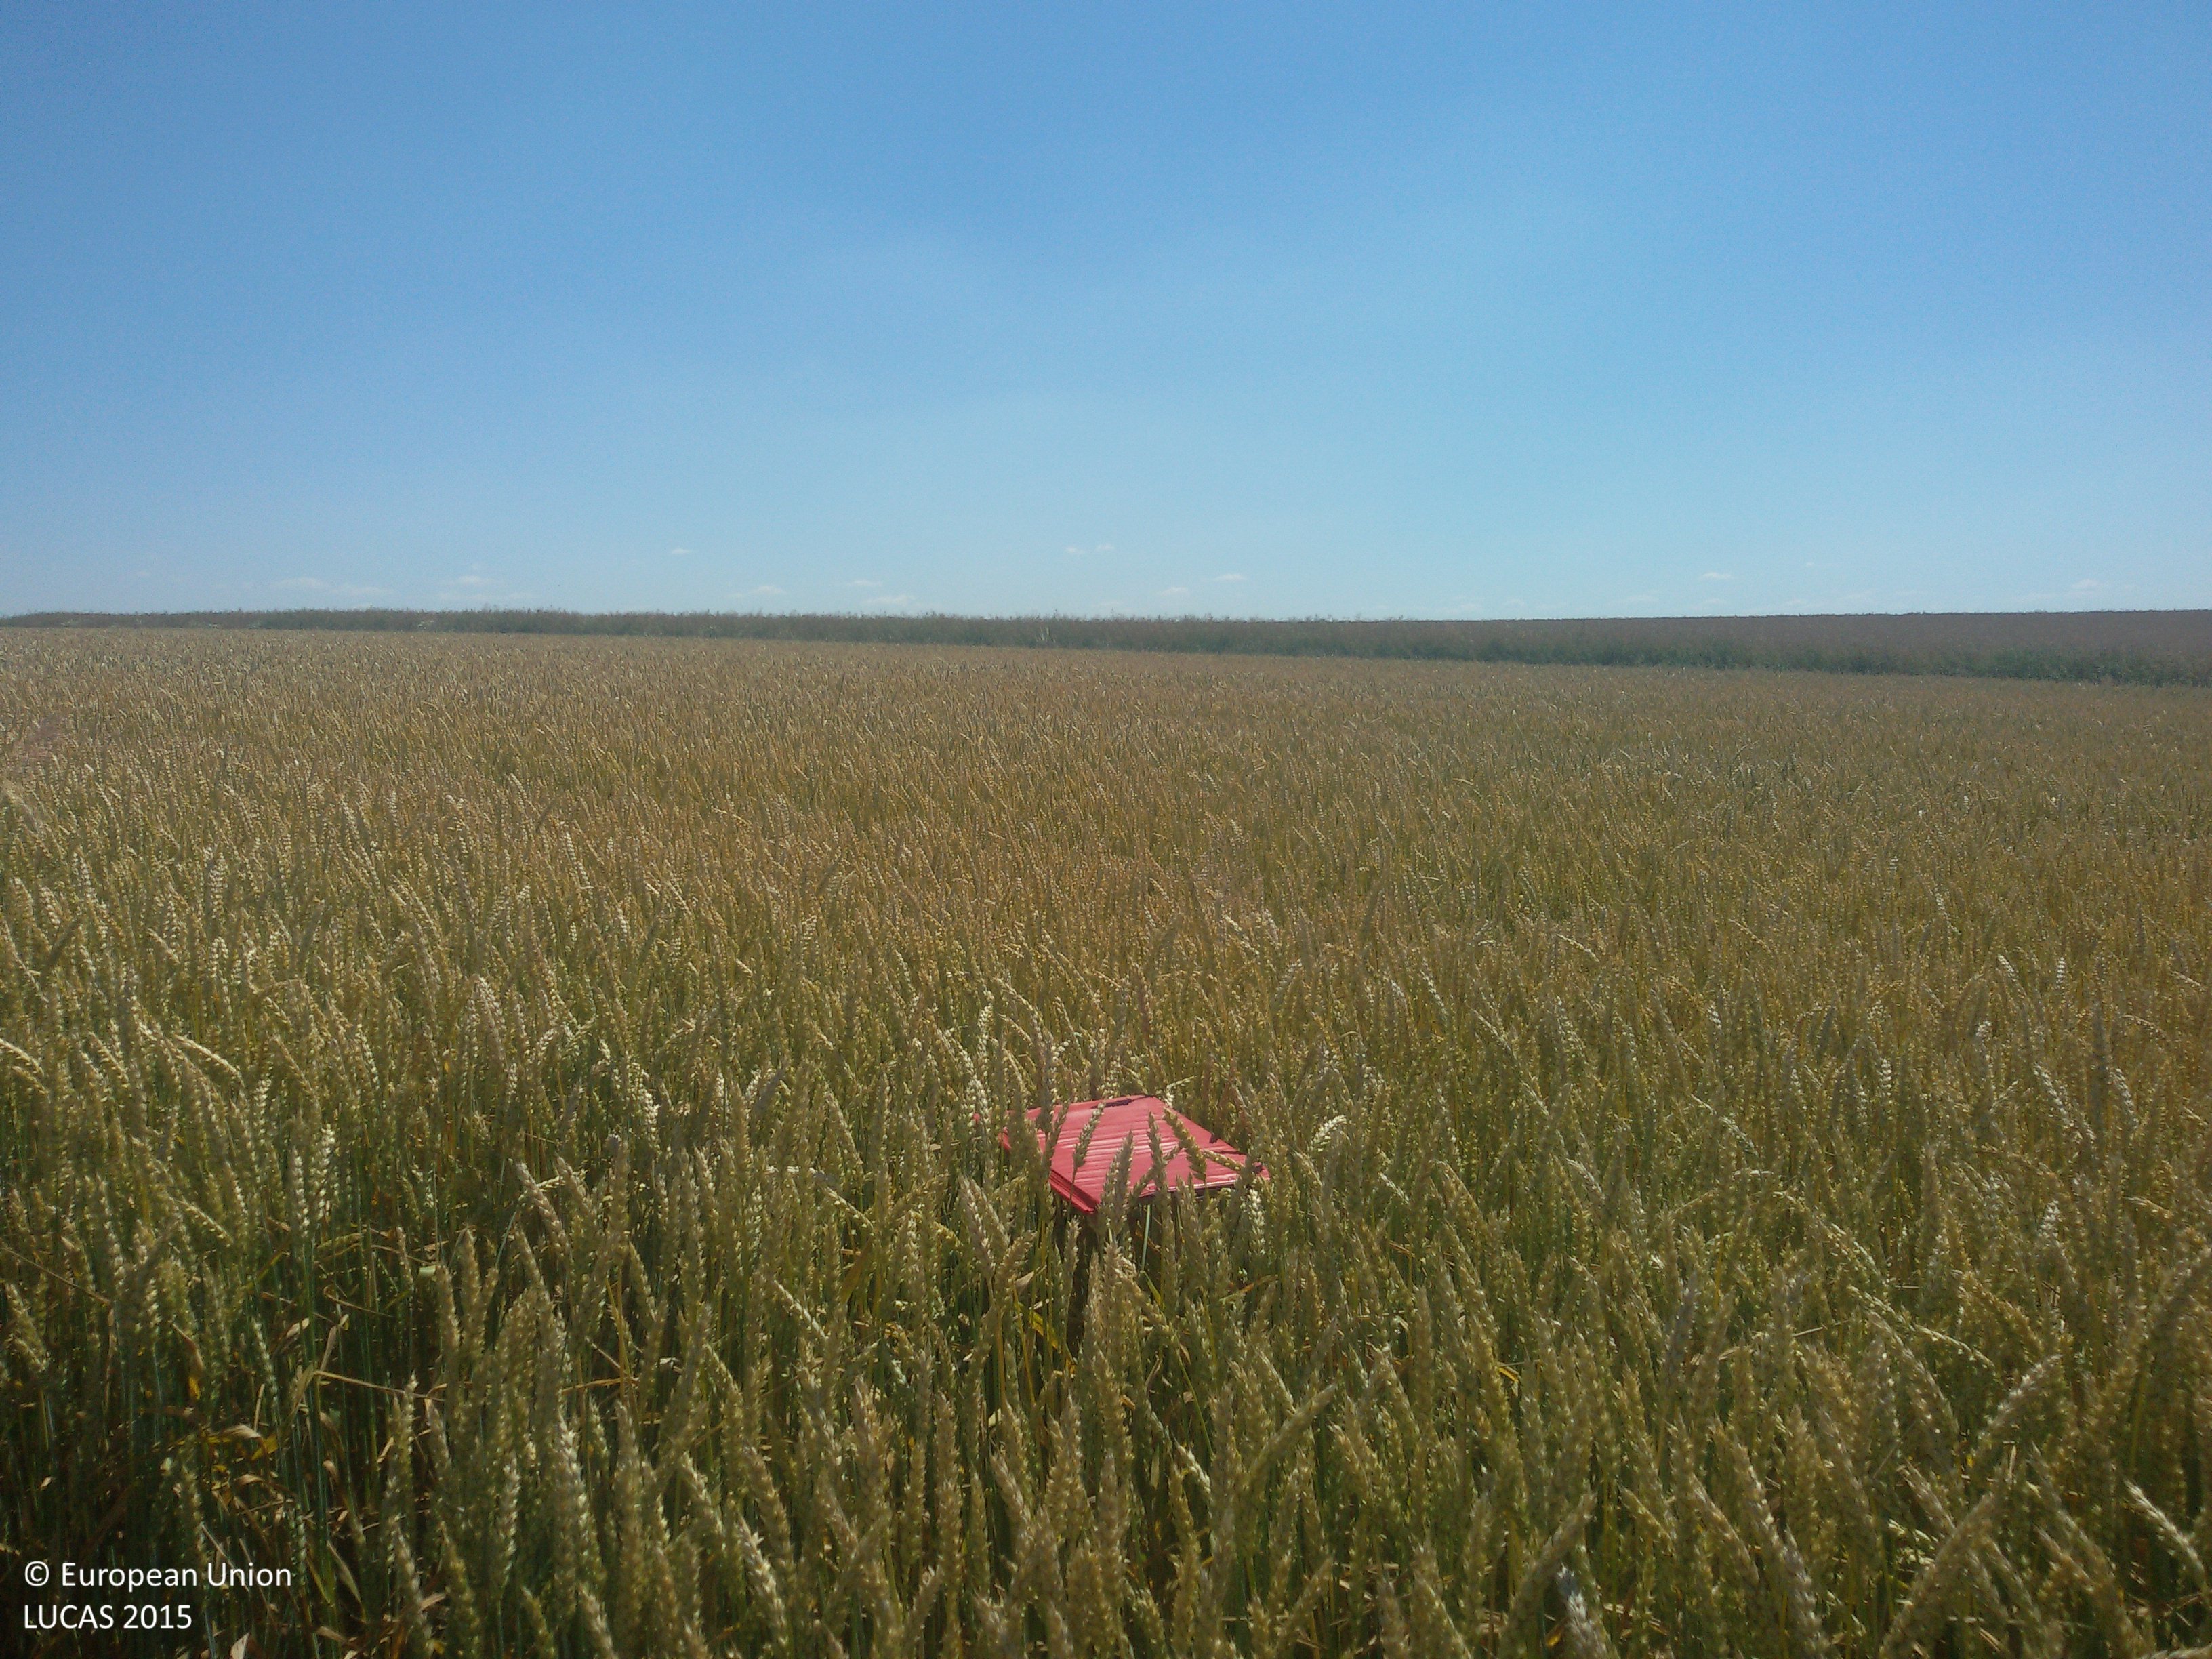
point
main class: Cropland
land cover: Common wheat
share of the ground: > 75 %
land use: Agriculture (excluding fallow land and kitchen gardens)
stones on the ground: < 10 %
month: July
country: PL
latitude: 50.3984
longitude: 17.6242
